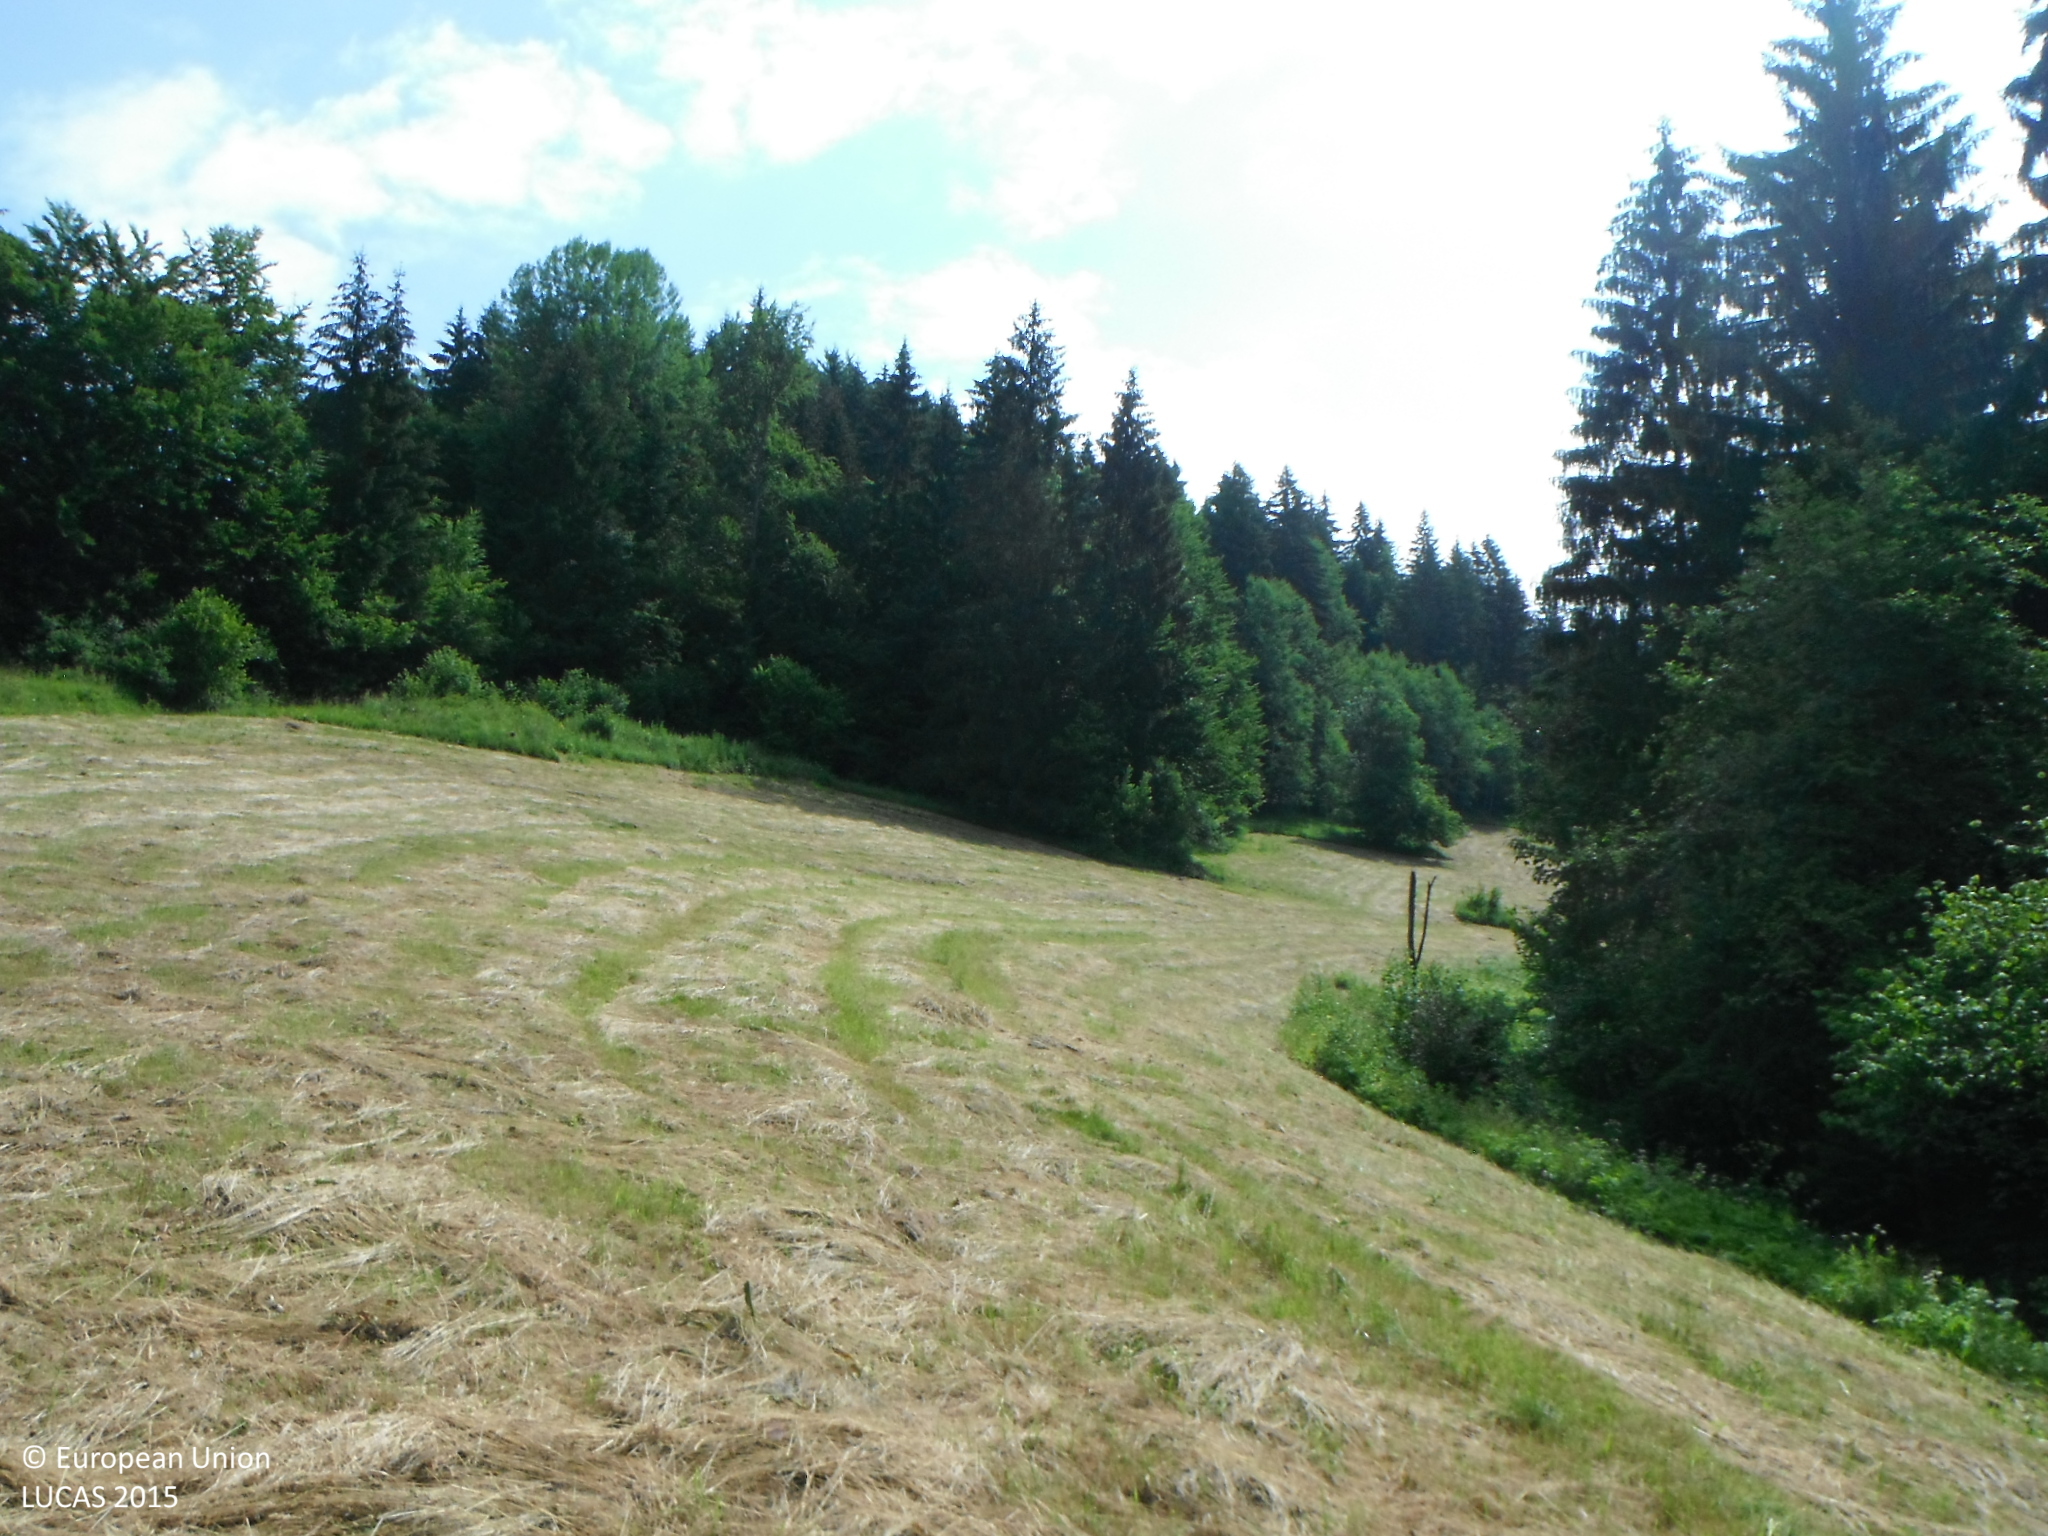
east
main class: Grassland
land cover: Grassland without tree/shrub cover
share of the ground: > 75 %
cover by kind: herbaceous plants 100 %
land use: Agriculture (excluding fallow land and kitchen gardens)
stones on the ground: < 10 %
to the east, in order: Grassland without tree/shrub cover; Spruce dominated mixed woodland; Tracks; Spruce dominated mixed woodland
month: June
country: SK
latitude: 49.2356
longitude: 19.3780
